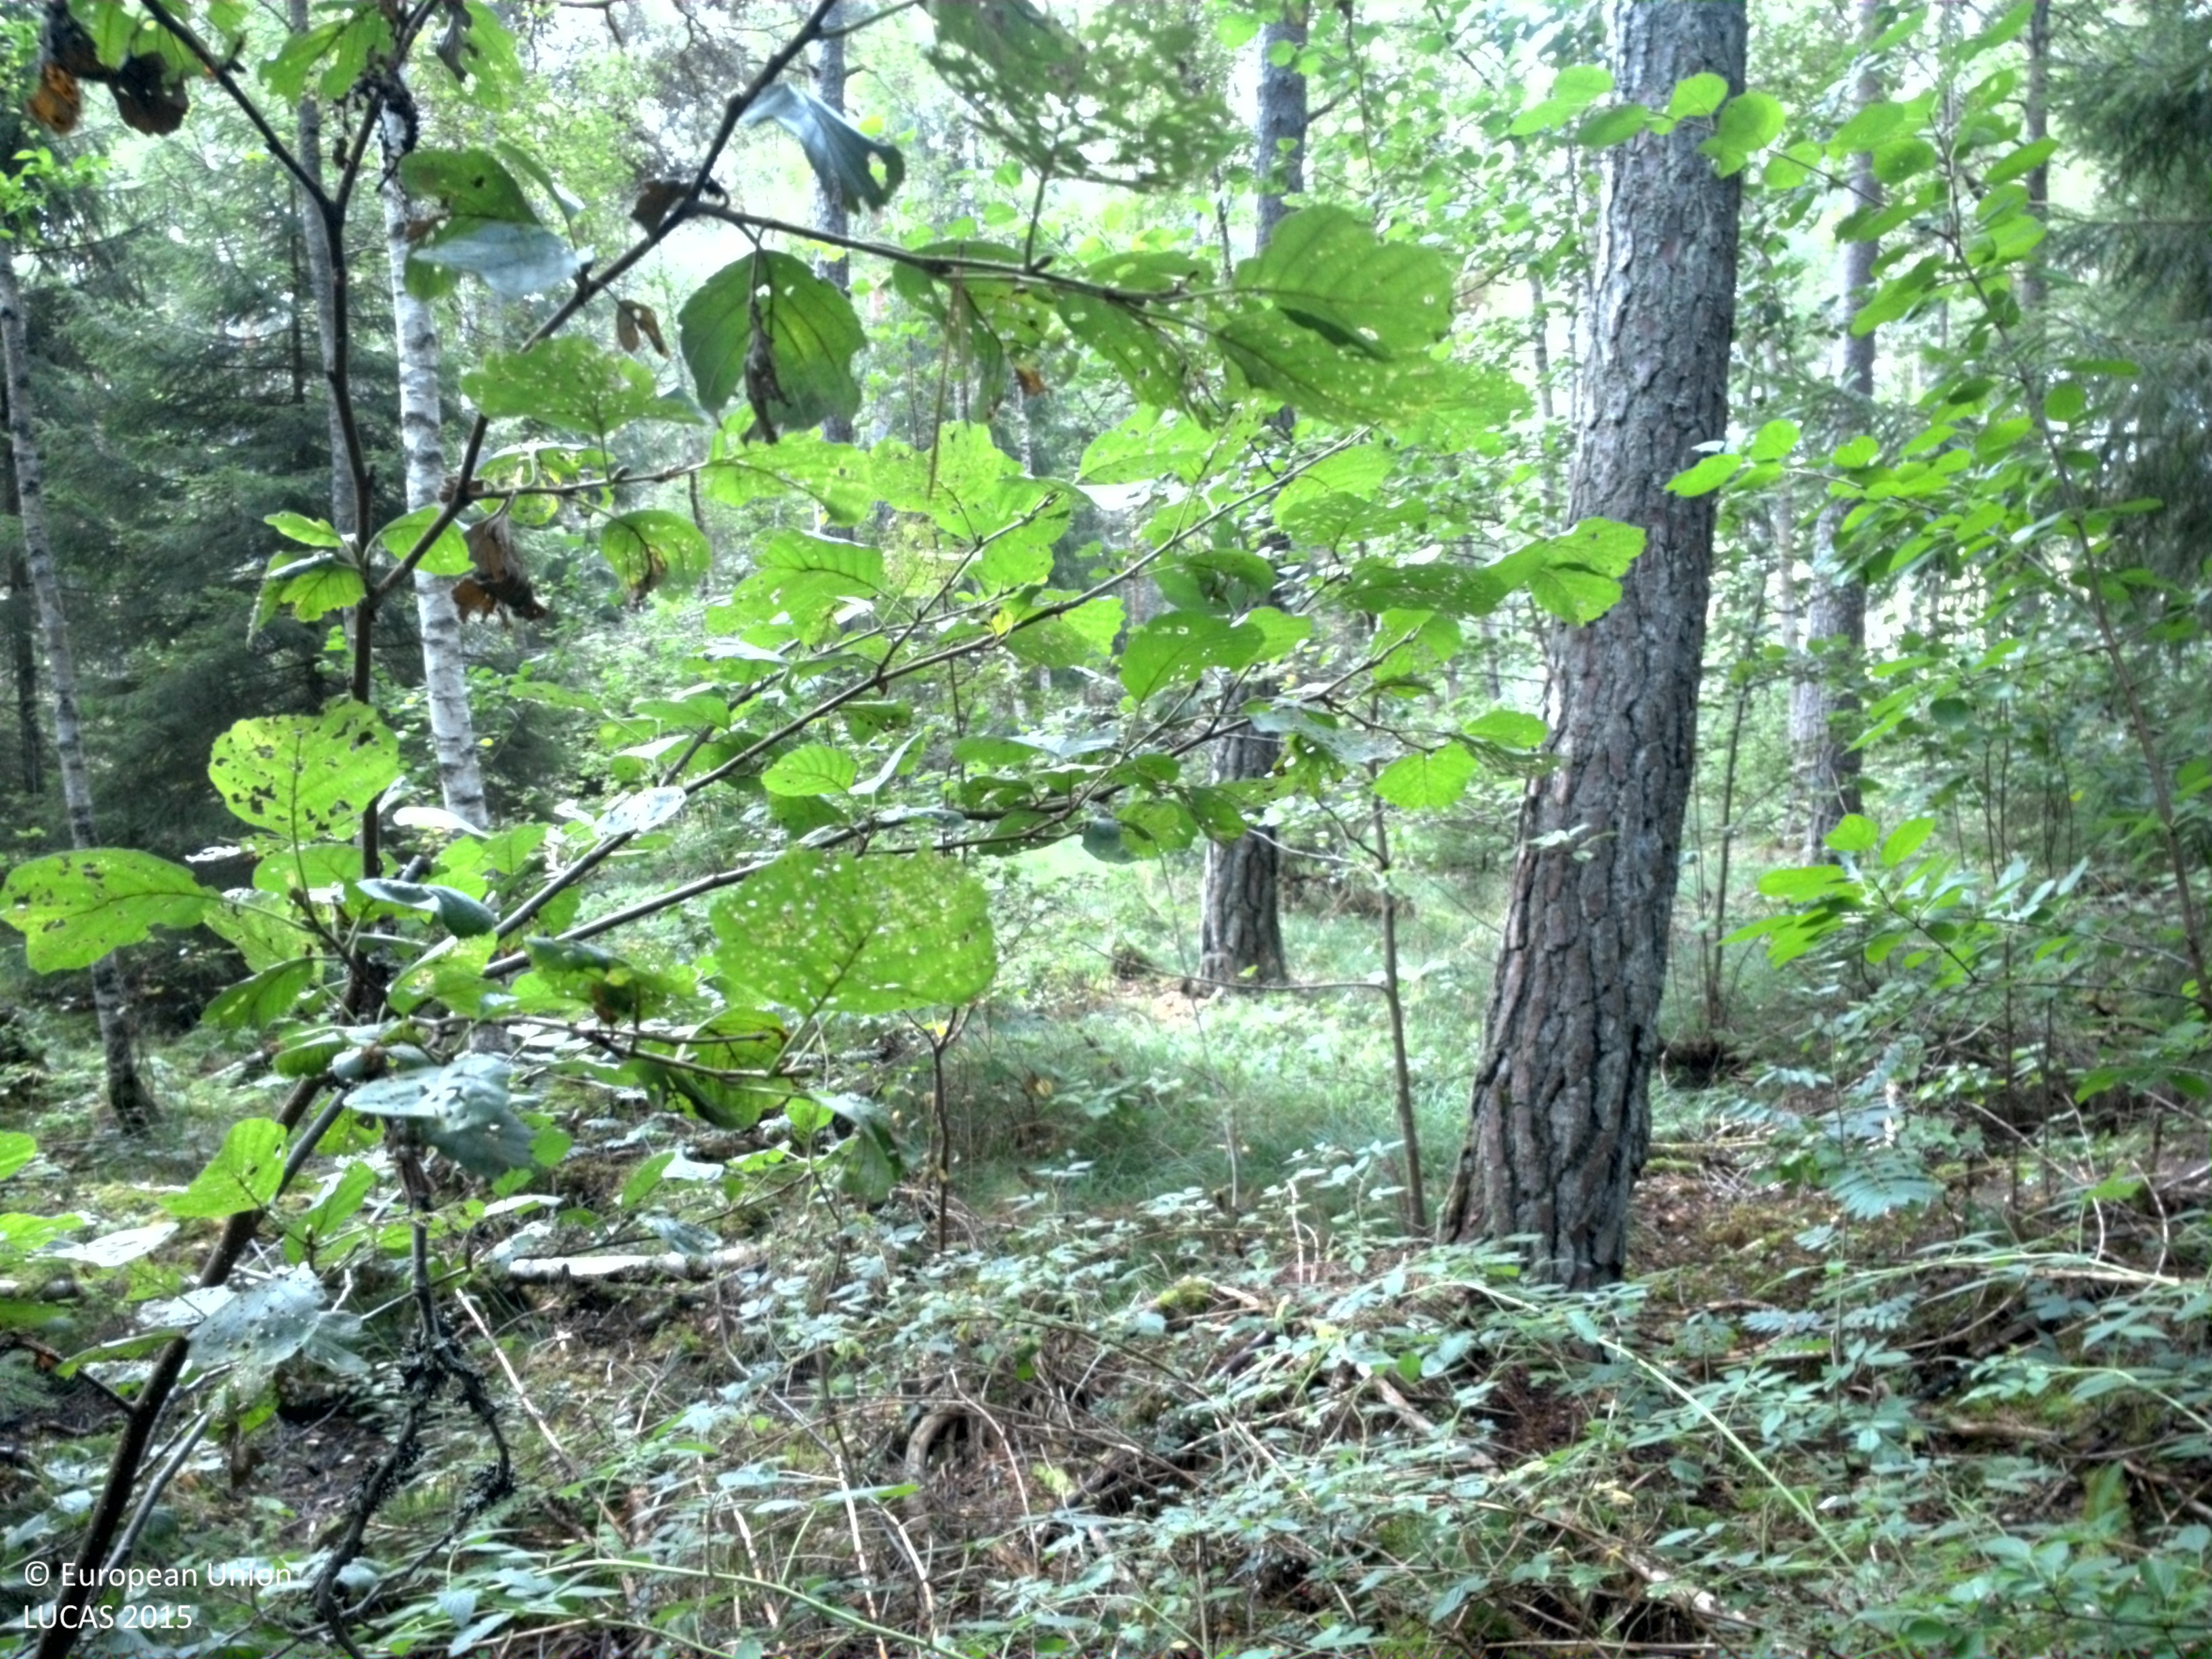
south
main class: Woodland
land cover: Spruce dominated mixed woodland
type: boreal forest
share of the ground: > 75 %
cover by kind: coniferous forest trees 55 %, broadleaved forest trees 20 %, herbaceous plants 15 %, lichens and mosses 10 %
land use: Forestry
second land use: Amenities, museums, leisure
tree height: > 5 m
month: August
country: SE
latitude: 59.9515
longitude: 17.7108
